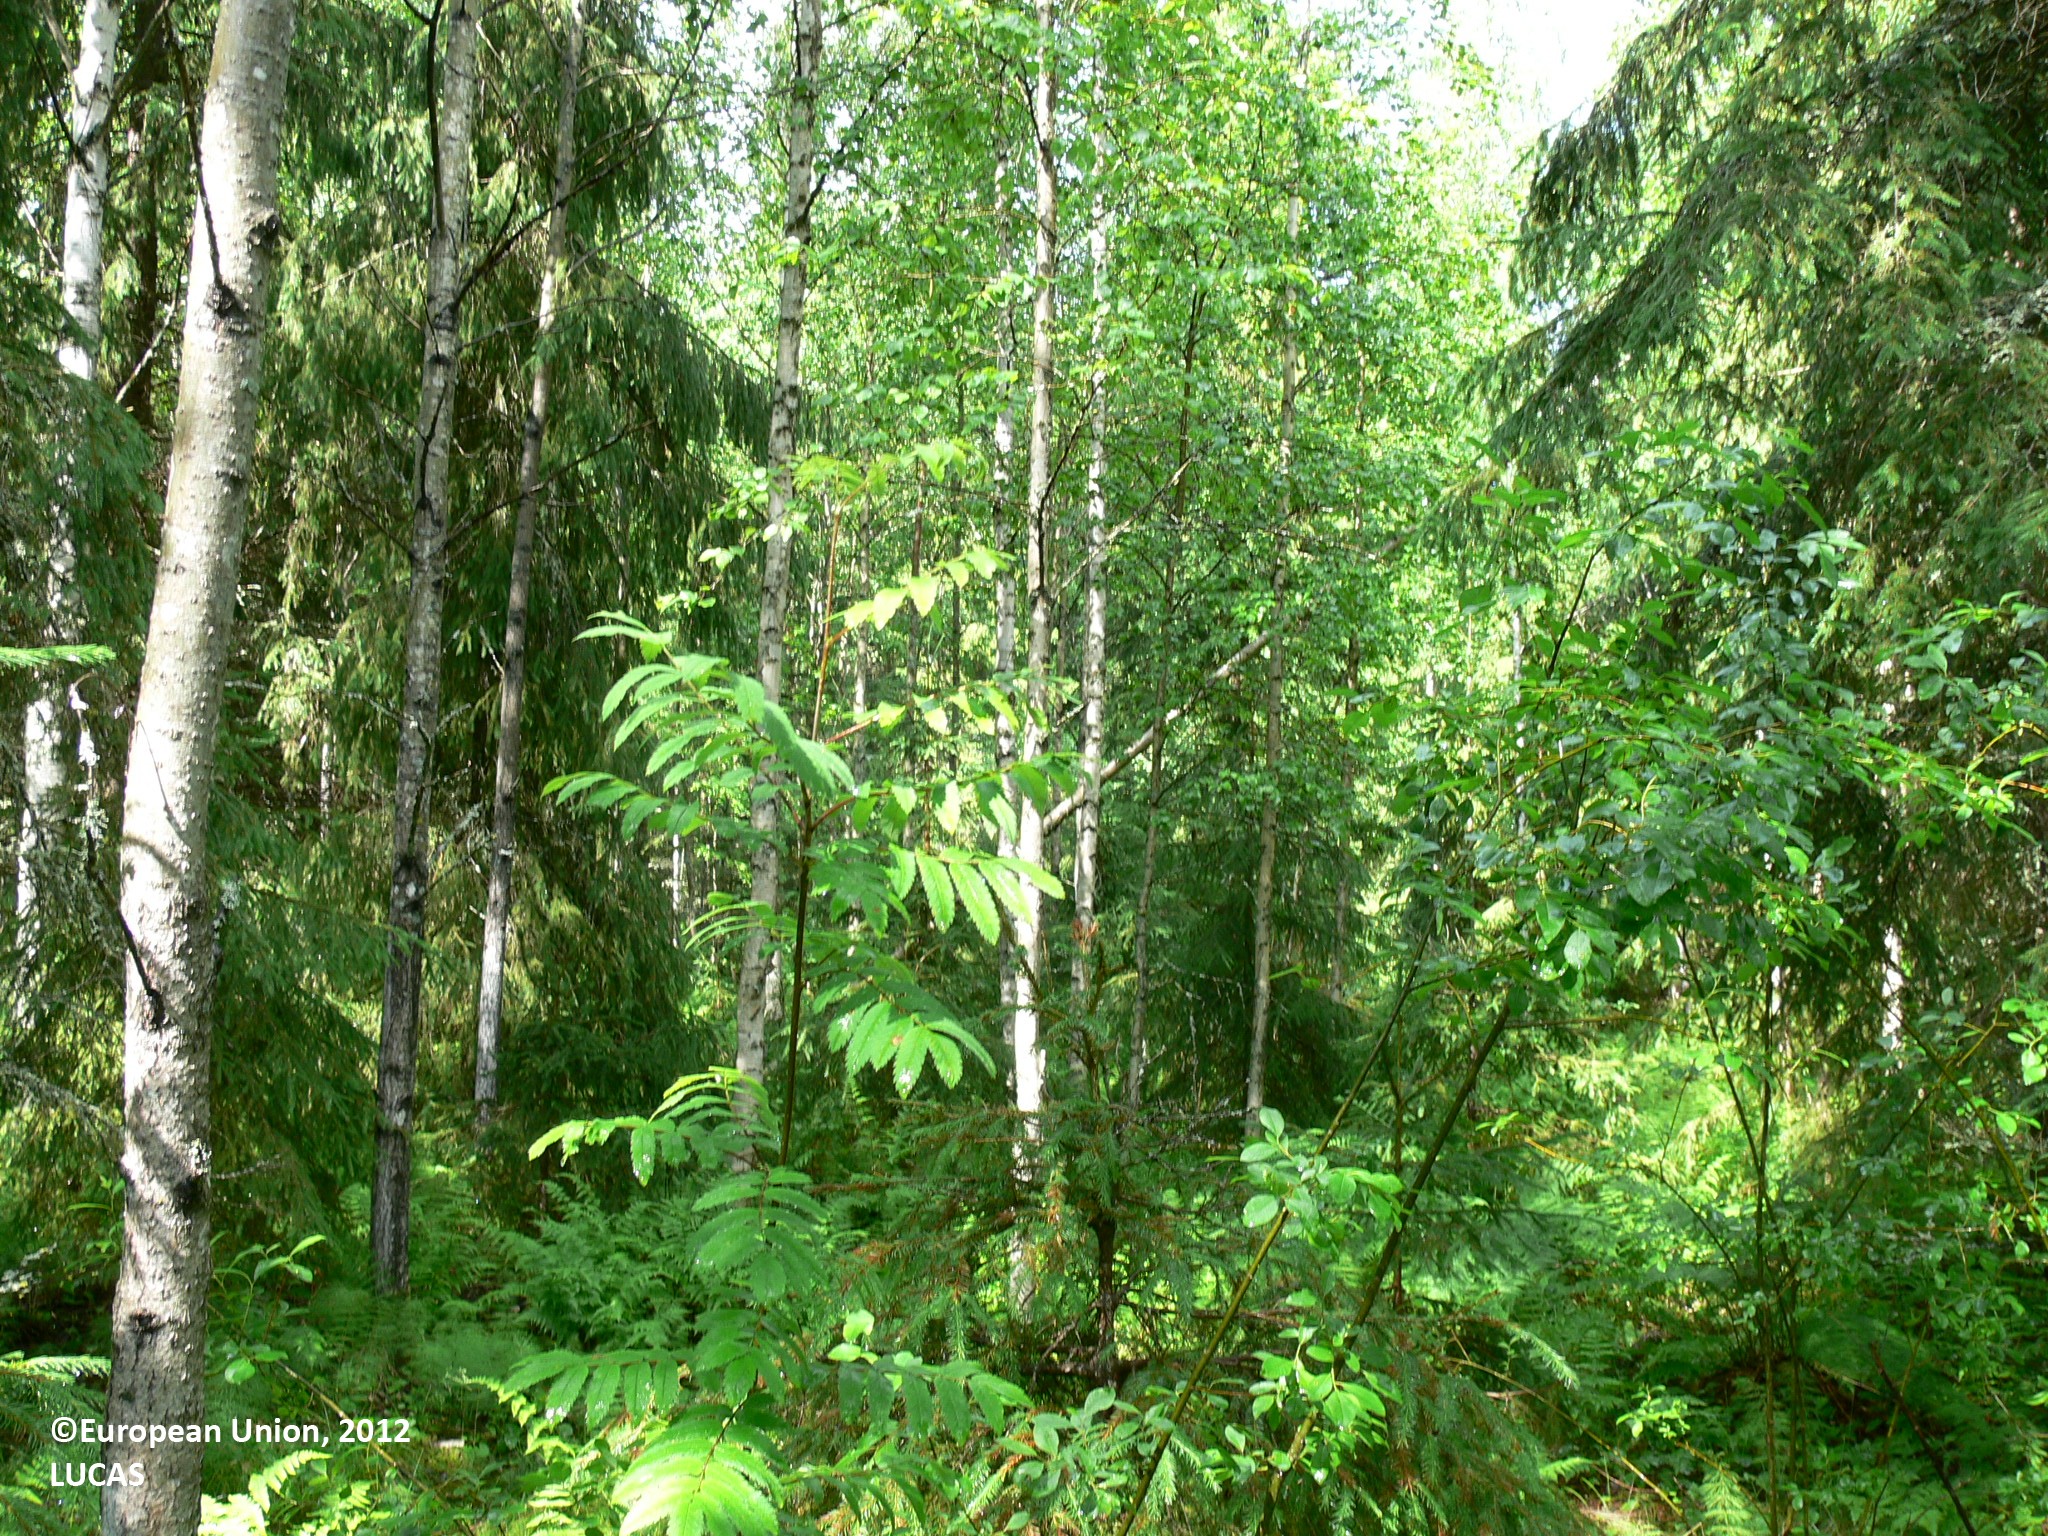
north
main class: Woodland
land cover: Spruce dominated mixed woodland
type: boreal forest
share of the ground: > 75 %
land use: Forestry
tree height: > 5 m
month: July
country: FI
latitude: 63.2412
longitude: 29.9376
